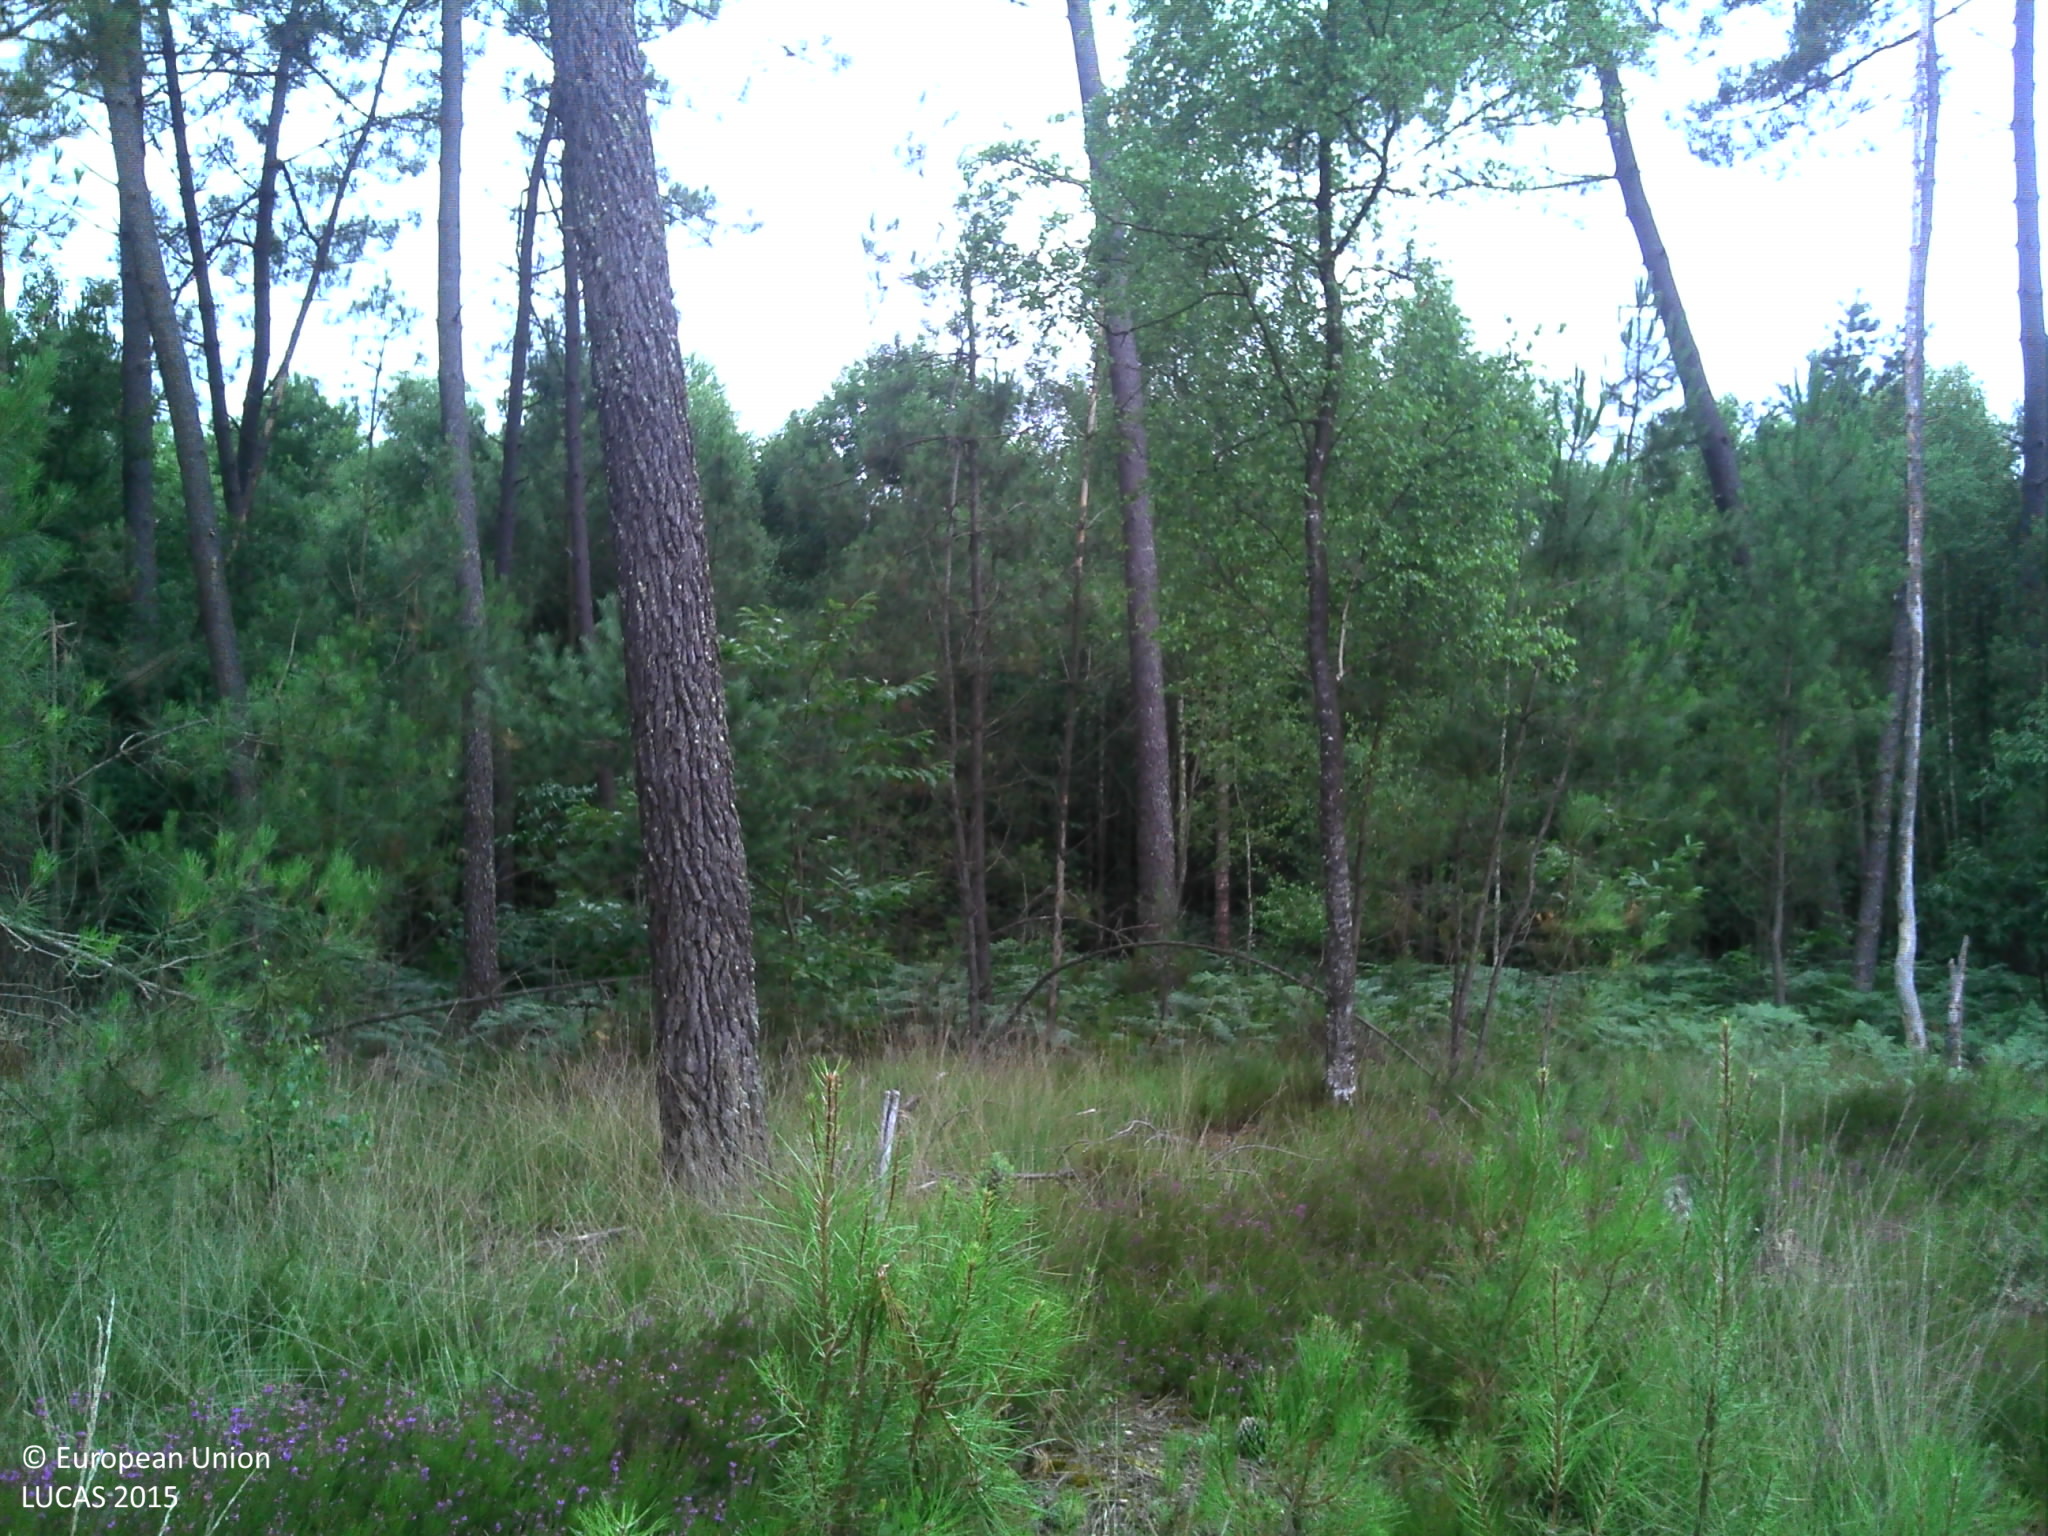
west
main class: Woodland
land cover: Pine dominated coniferous woodland
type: exotic forest
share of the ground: 50 - 75 %
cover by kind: coniferous forest trees 50 %, herbaceous plants 30 %, shrubs 20 %
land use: Forestry
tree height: < 5 m
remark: Nursery
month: July
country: FR
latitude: 47.8776
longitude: 0.4161
